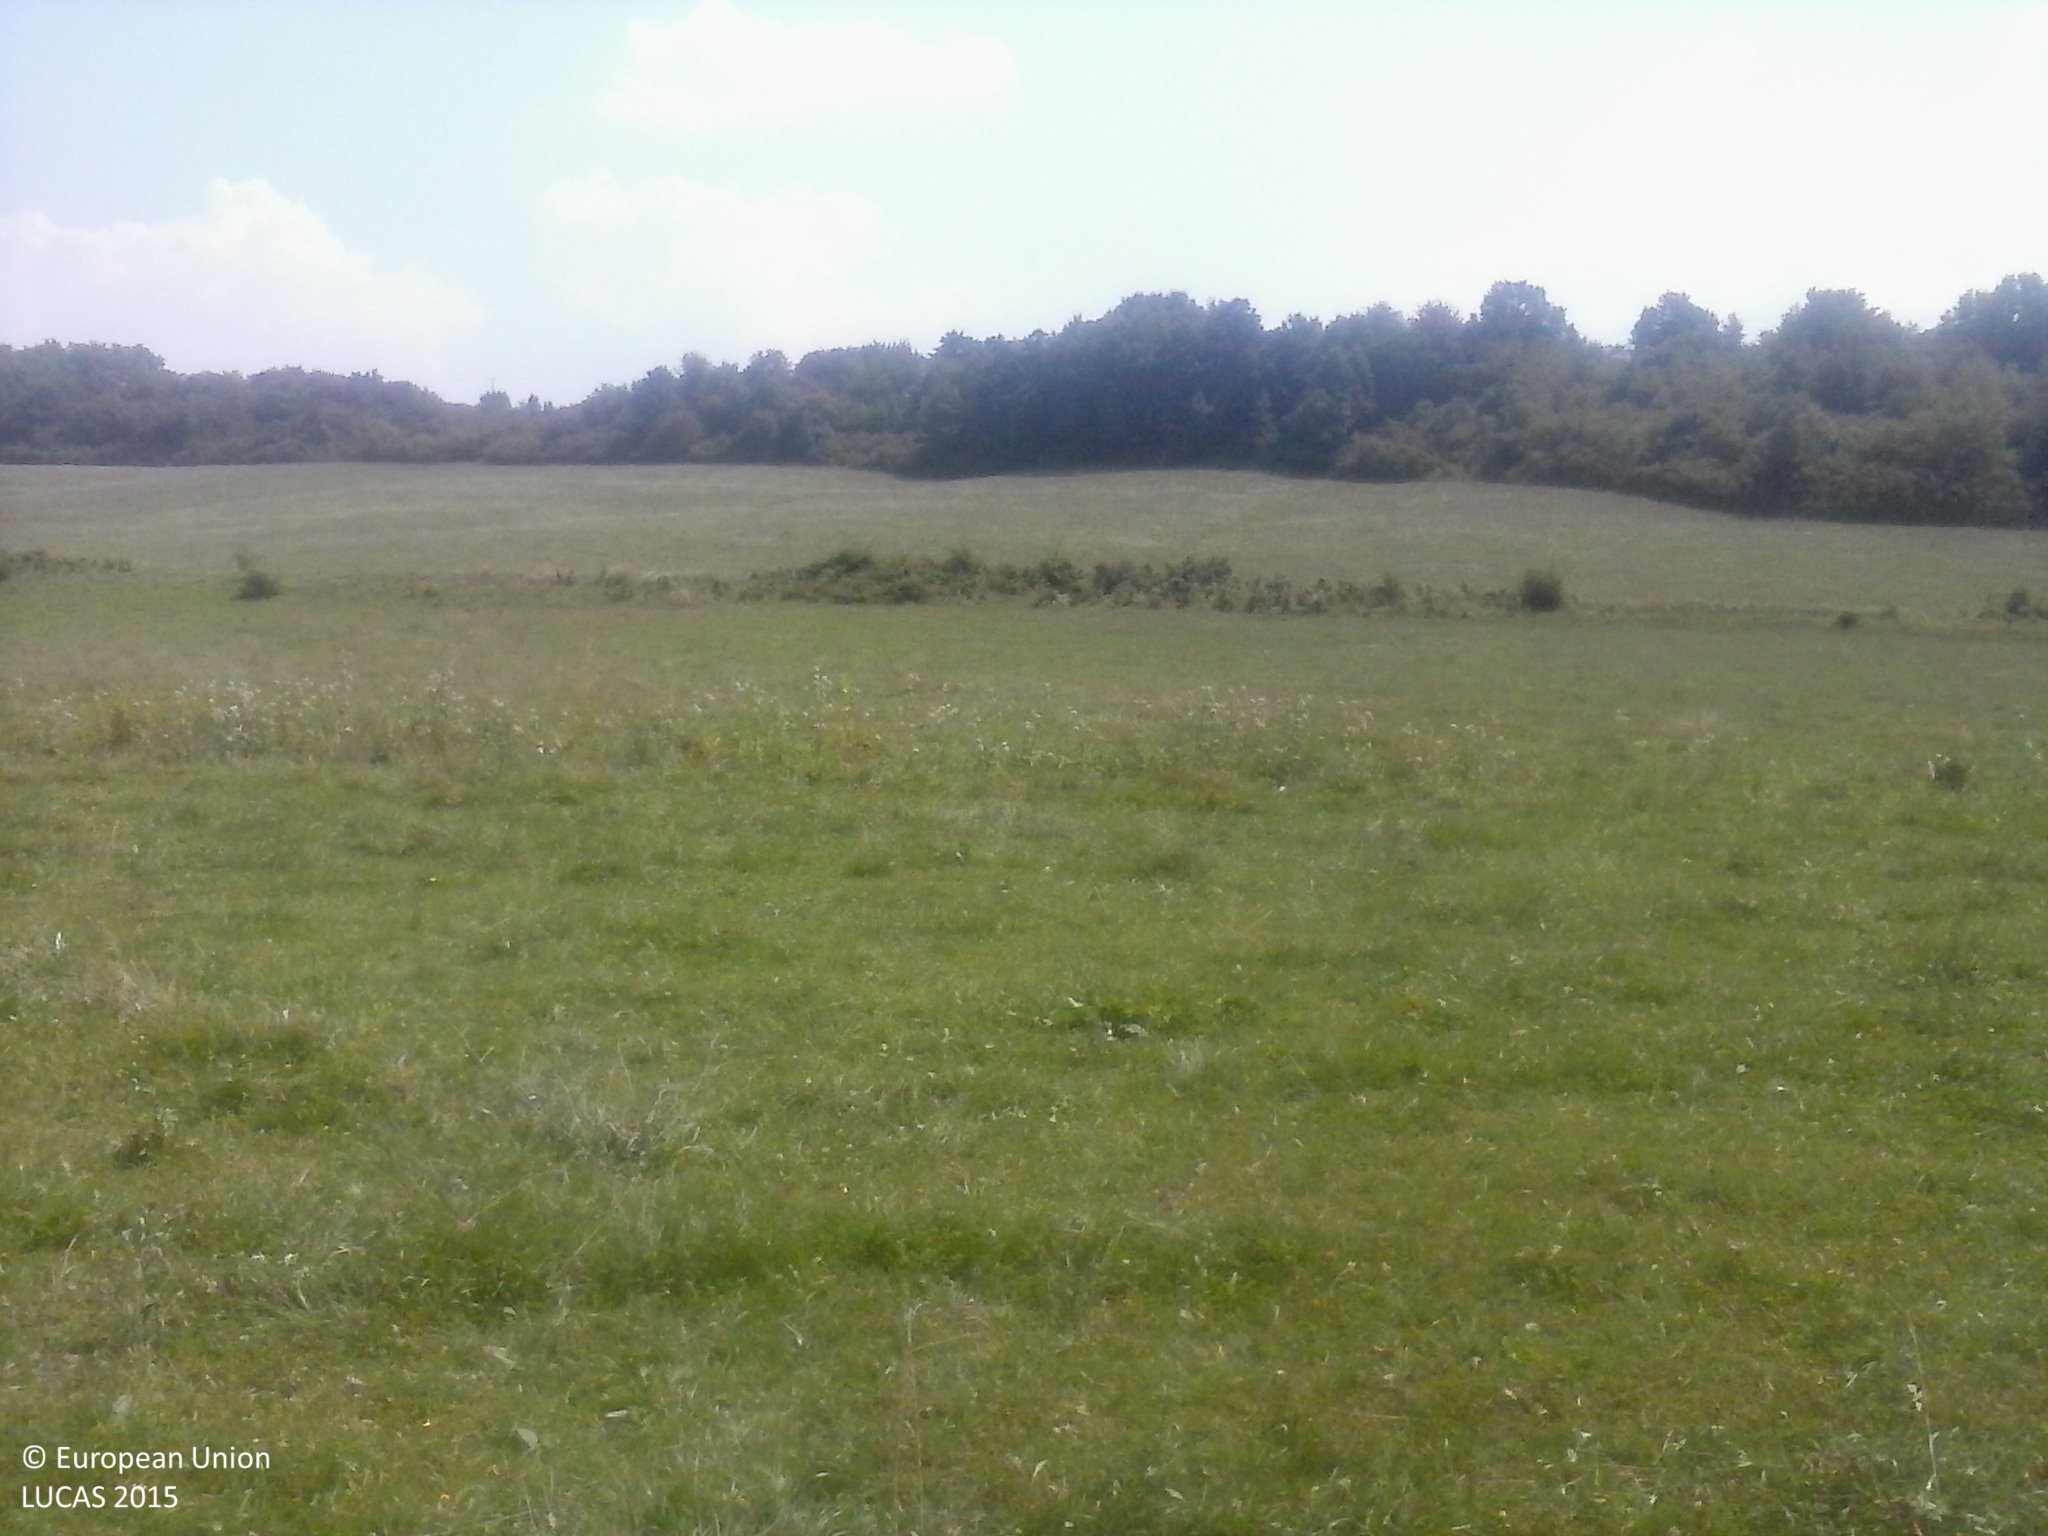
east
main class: Grassland
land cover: Grassland without tree/shrub cover
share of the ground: > 75 %
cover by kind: herbaceous plants 100 %
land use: Agriculture (excluding fallow land and kitchen gardens)
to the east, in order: Grassland without tree/shrub cover; Ditches and canals; Grassland without tree/shrub cover; Abandoned hedges; Grassland without tree/shrub cover
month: August
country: HU
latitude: 46.1838
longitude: 17.9216
